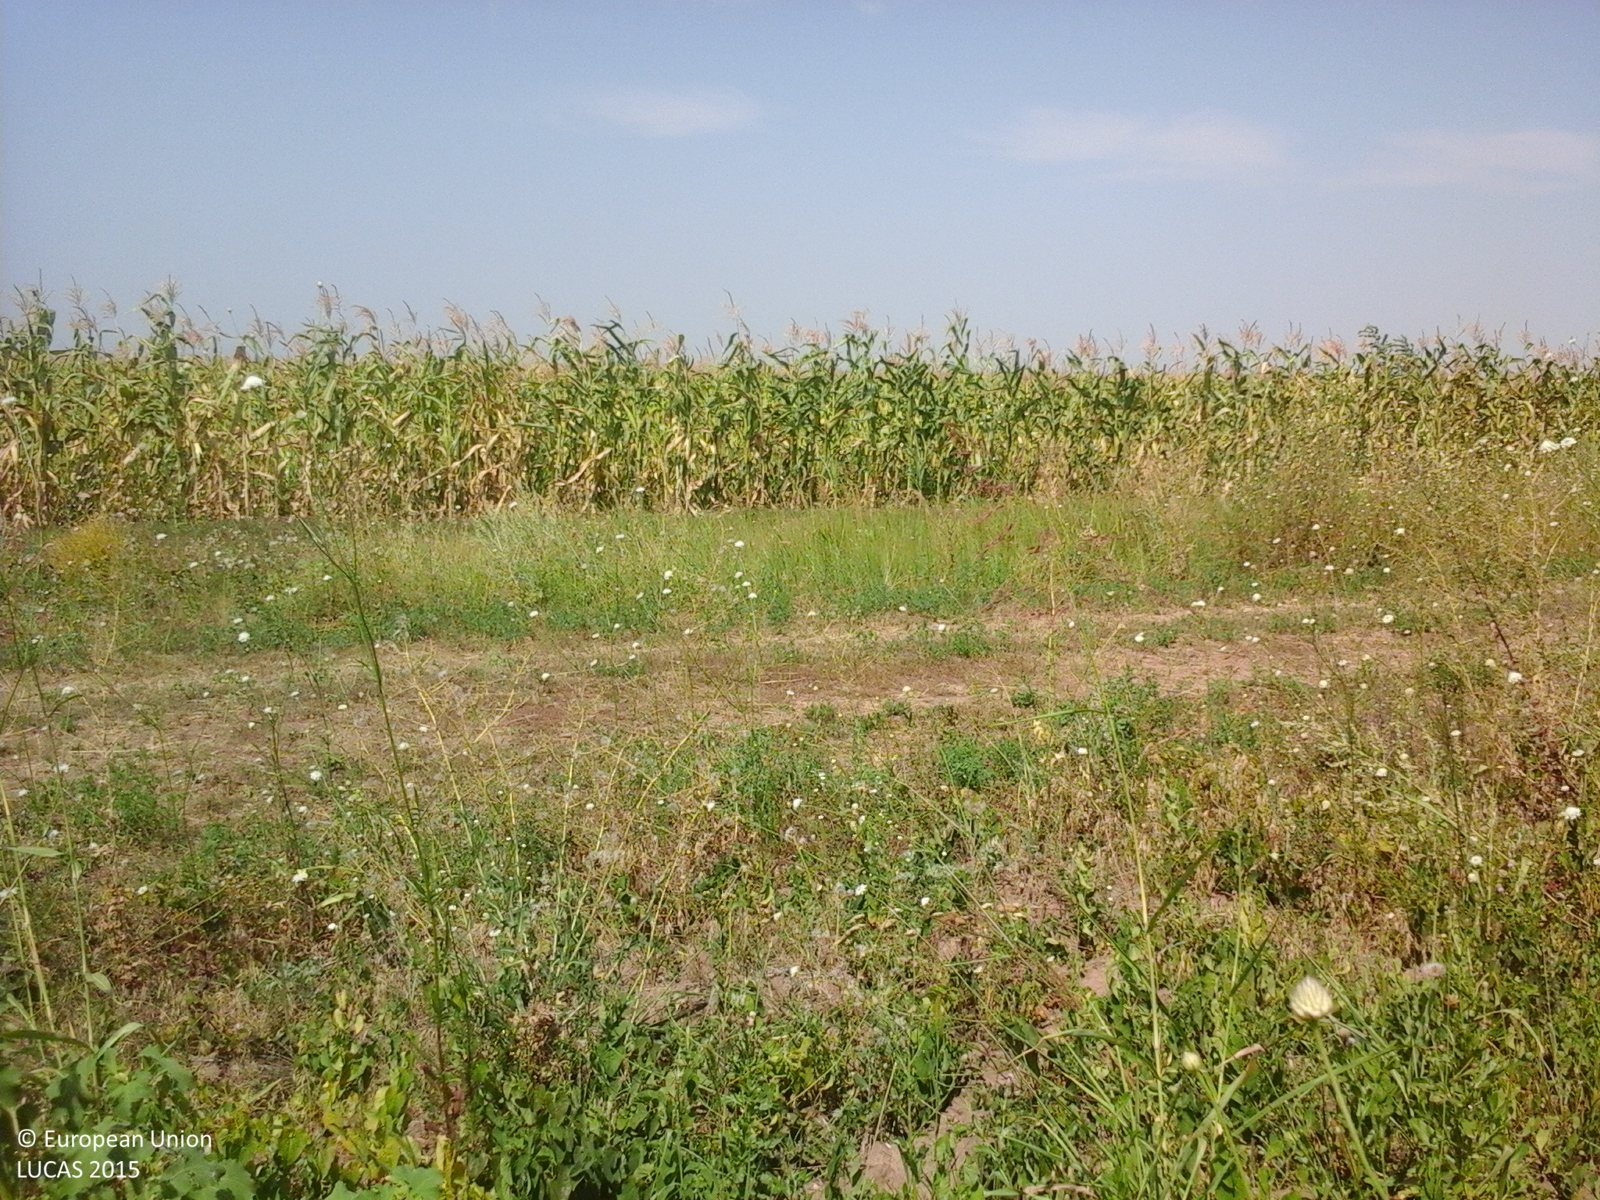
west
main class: Cropland
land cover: Maize
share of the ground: > 75 %
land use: Agriculture (excluding fallow land and kitchen gardens)
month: August
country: RO
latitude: 45.7546
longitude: 27.4188
